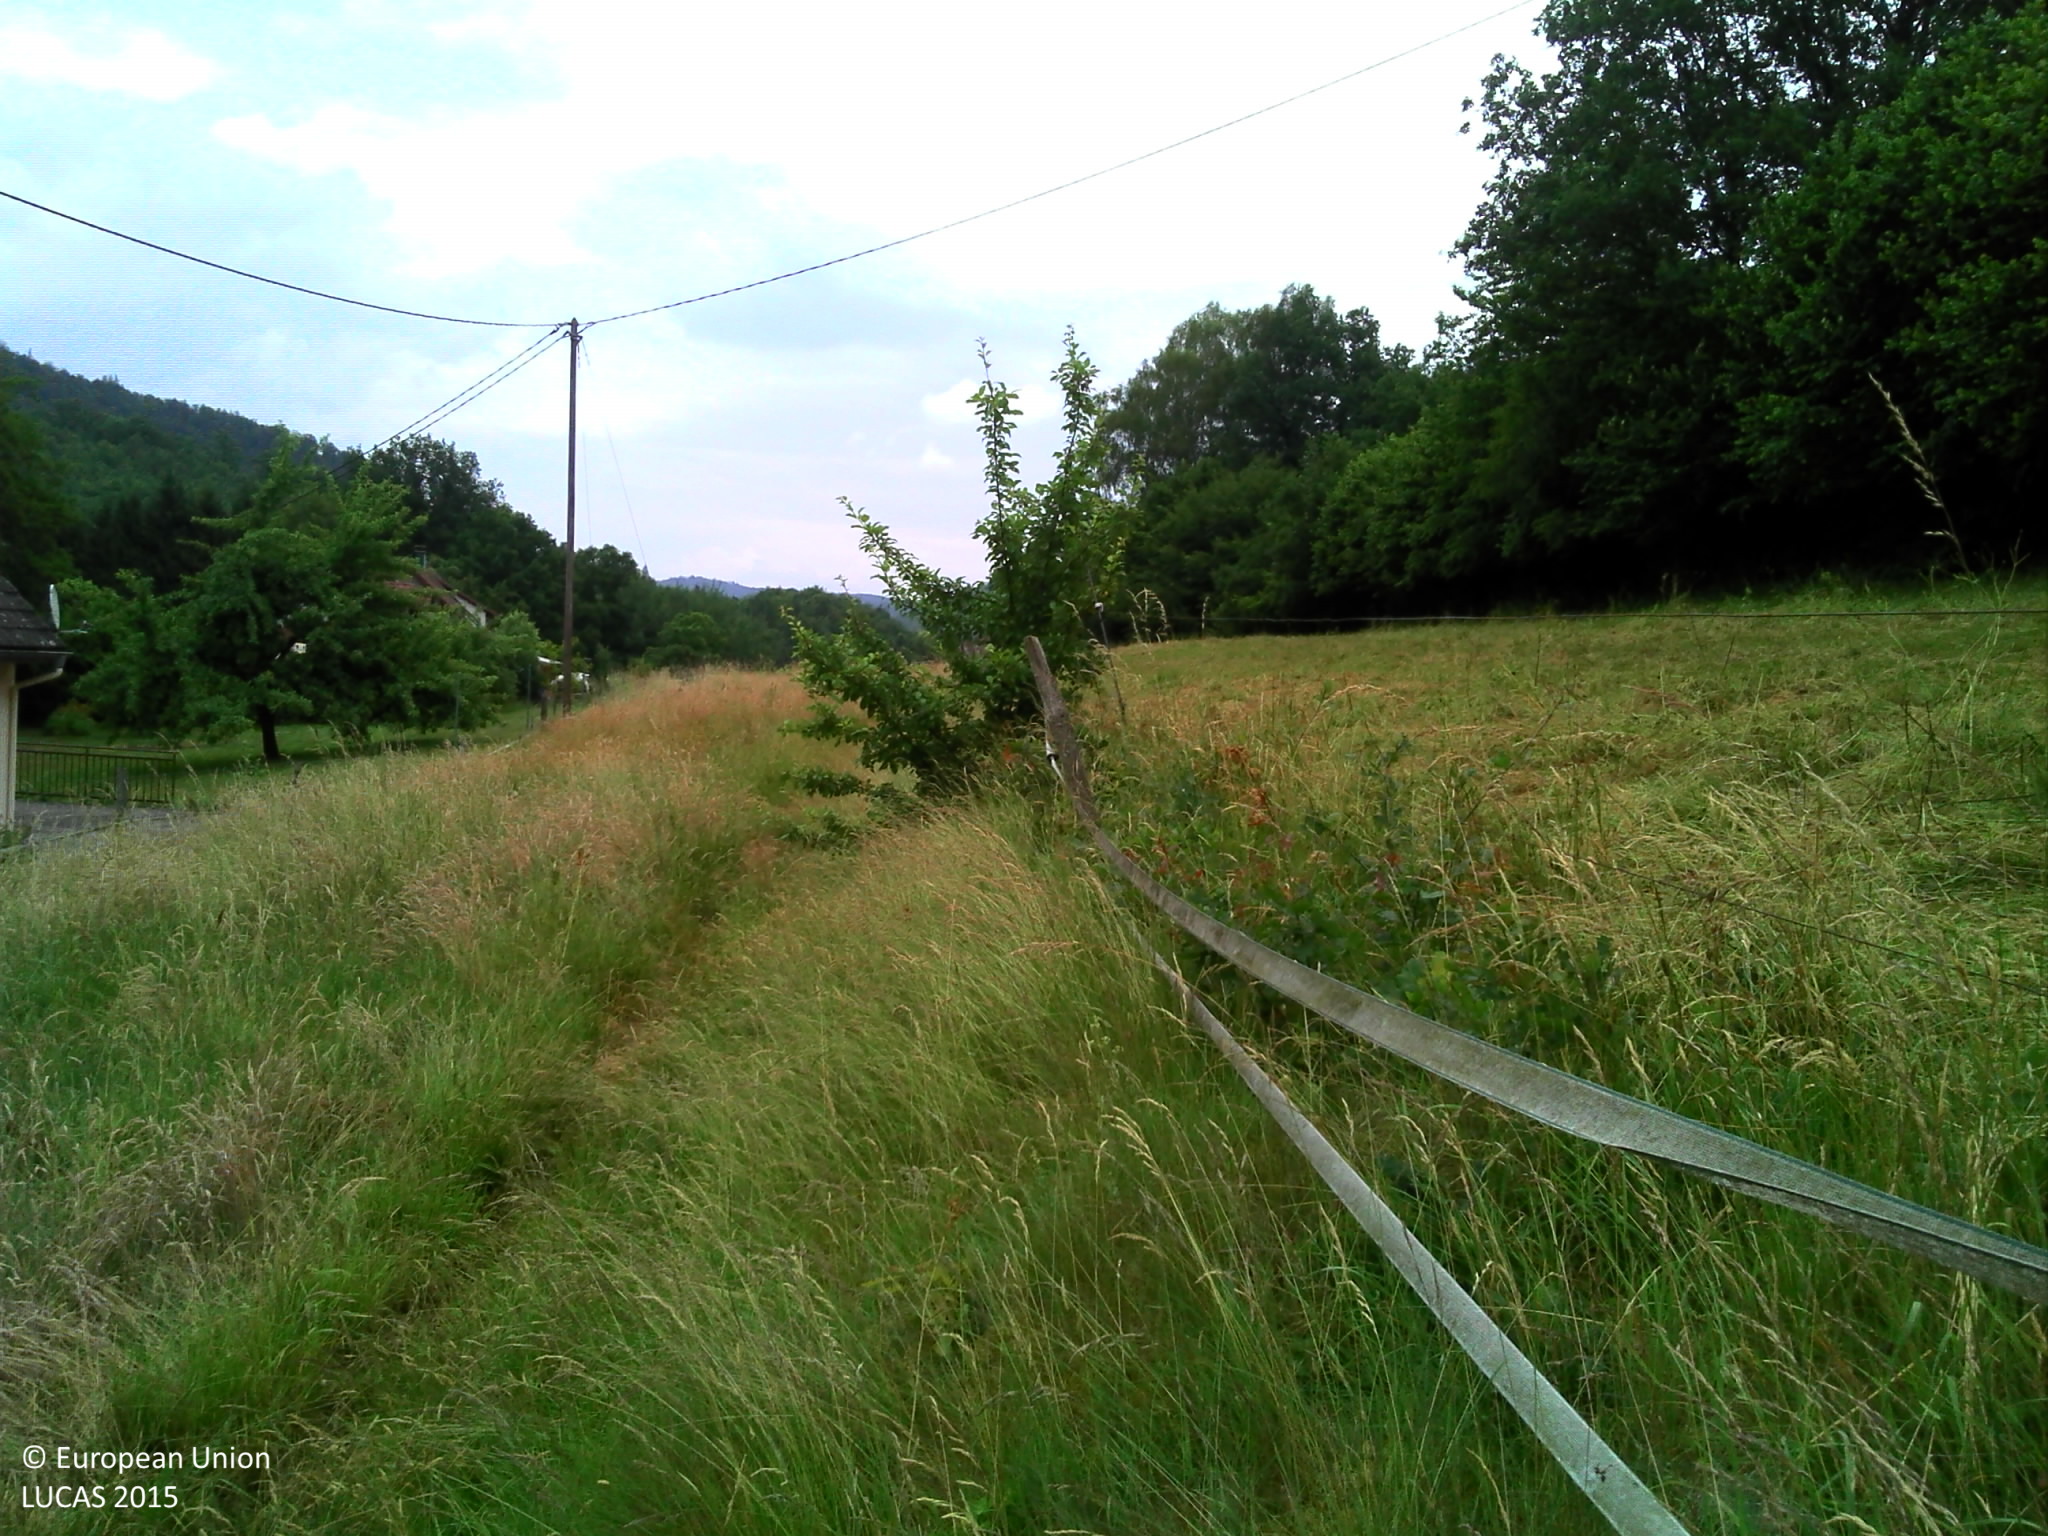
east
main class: Grassland
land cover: Grassland without tree/shrub cover
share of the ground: > 75 %
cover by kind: herbaceous plants 100 %
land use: Agriculture (excluding fallow land and kitchen gardens)
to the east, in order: Grassland without tree/shrub cover; Fences; Tracks; Broadleaved woodland; Fences; Grassland without tree/shrub cover; Single bushes/trees; Grassland without tree/shrub cover; Fences; Grass margins; Tracks; Grass margins; Fences; Grassland without tree/shrub cover; Fences; Grassland without tree/shrub cover; Broadleaved woodland
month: June
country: FR
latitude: 49.0279
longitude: 7.7166
